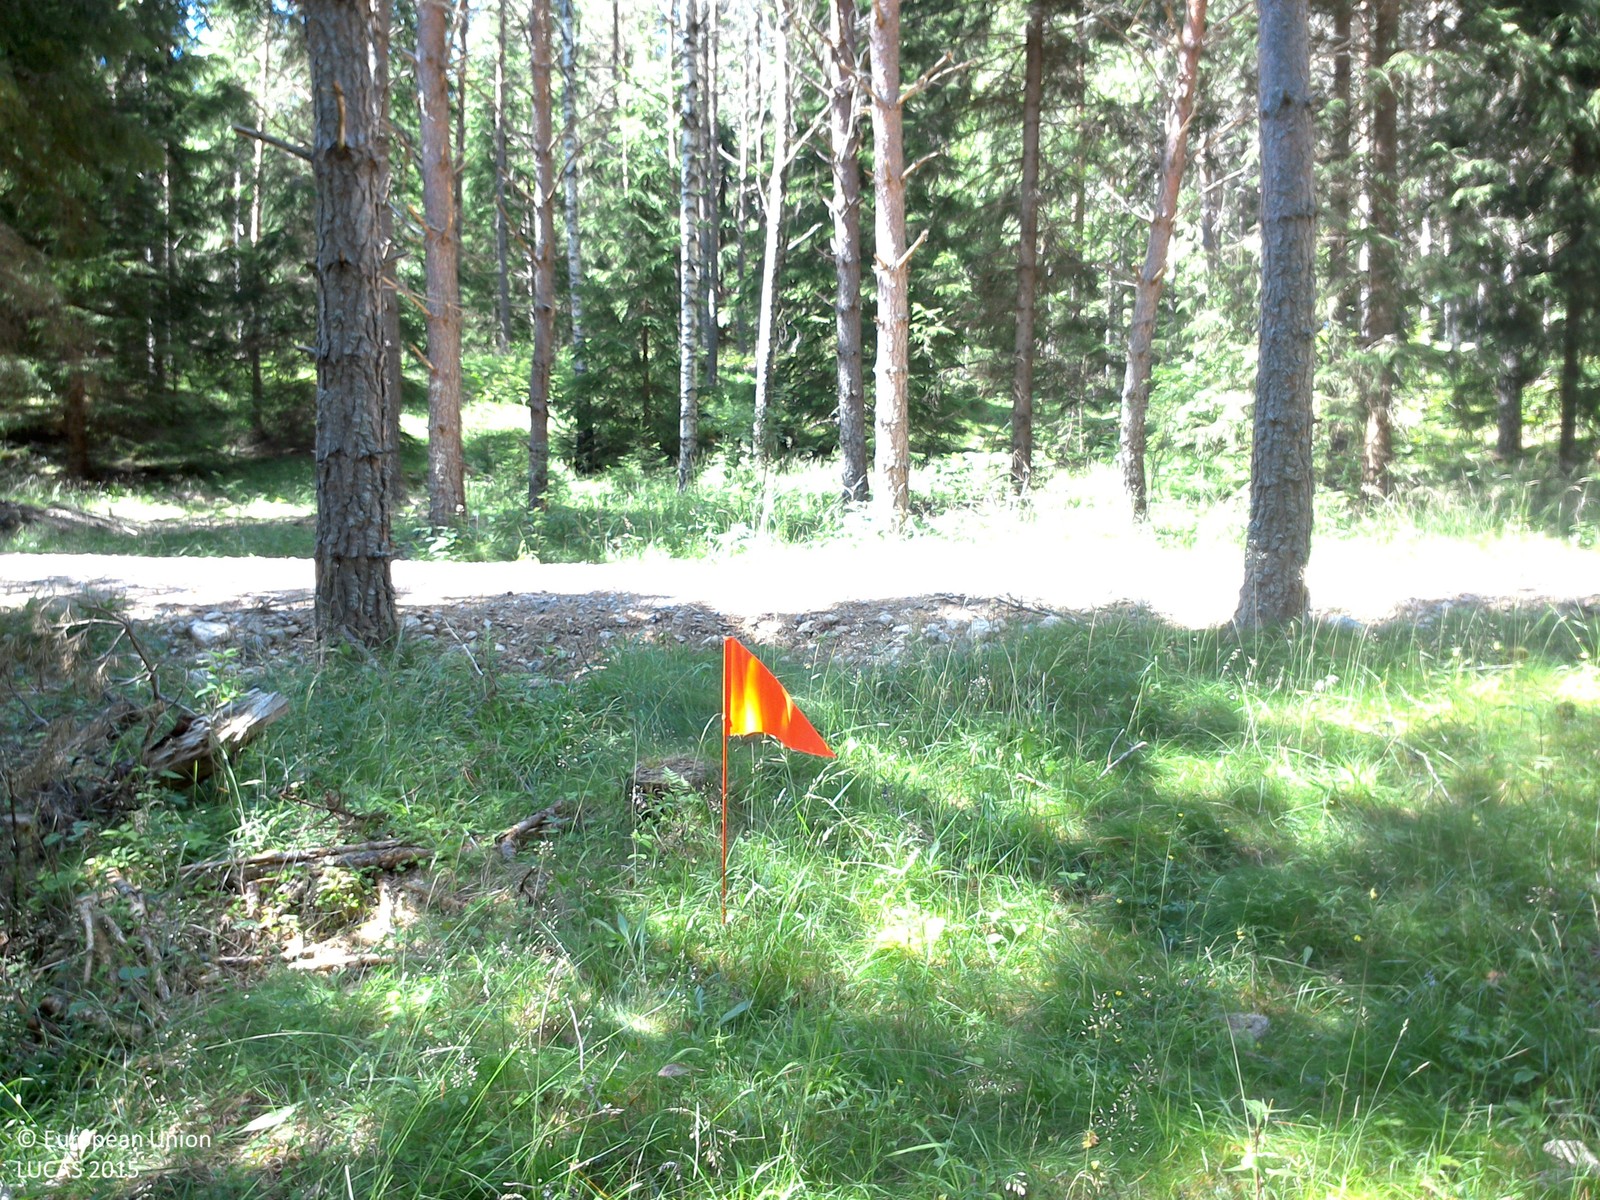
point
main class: Woodland
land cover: Pine dominated coniferous woodland
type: boreal forest
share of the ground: 50 - 75 %
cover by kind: coniferous forest trees 60 %, herbaceous plants 40 %
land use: Forestry
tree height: > 5 m
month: July
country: SE
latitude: 57.8920
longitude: 15.0051
